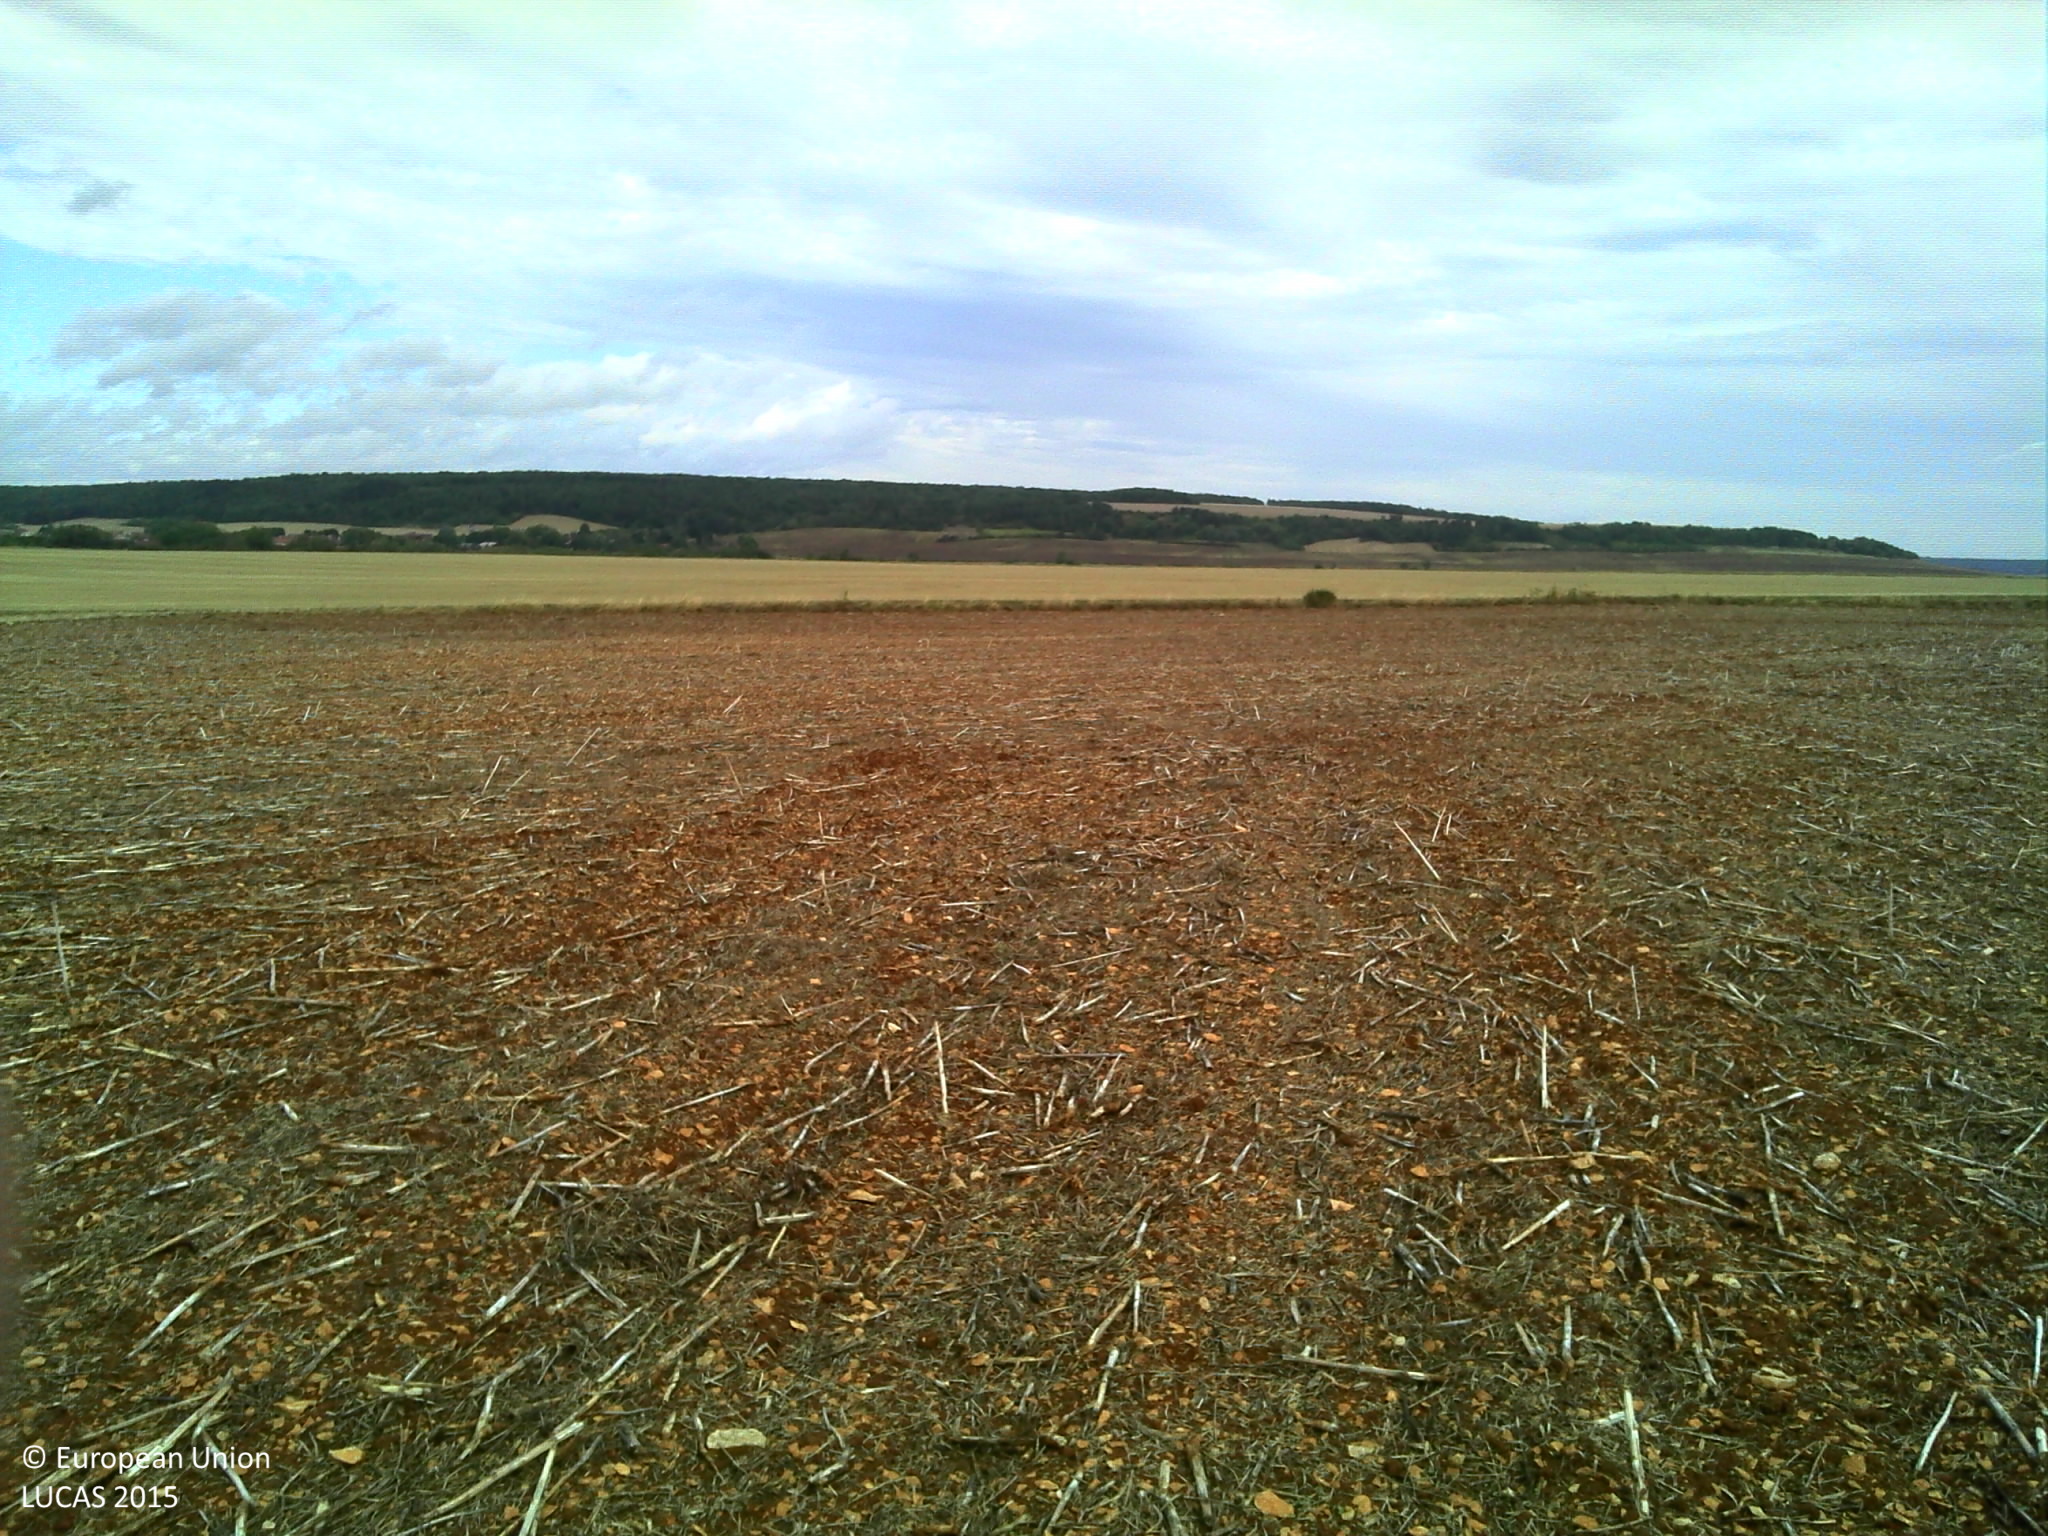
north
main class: Cropland
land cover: Rape and turnip rape
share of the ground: < 10 %
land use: Agriculture (excluding fallow land and kitchen gardens)
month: August
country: FR
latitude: 47.8997
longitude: 4.7417
